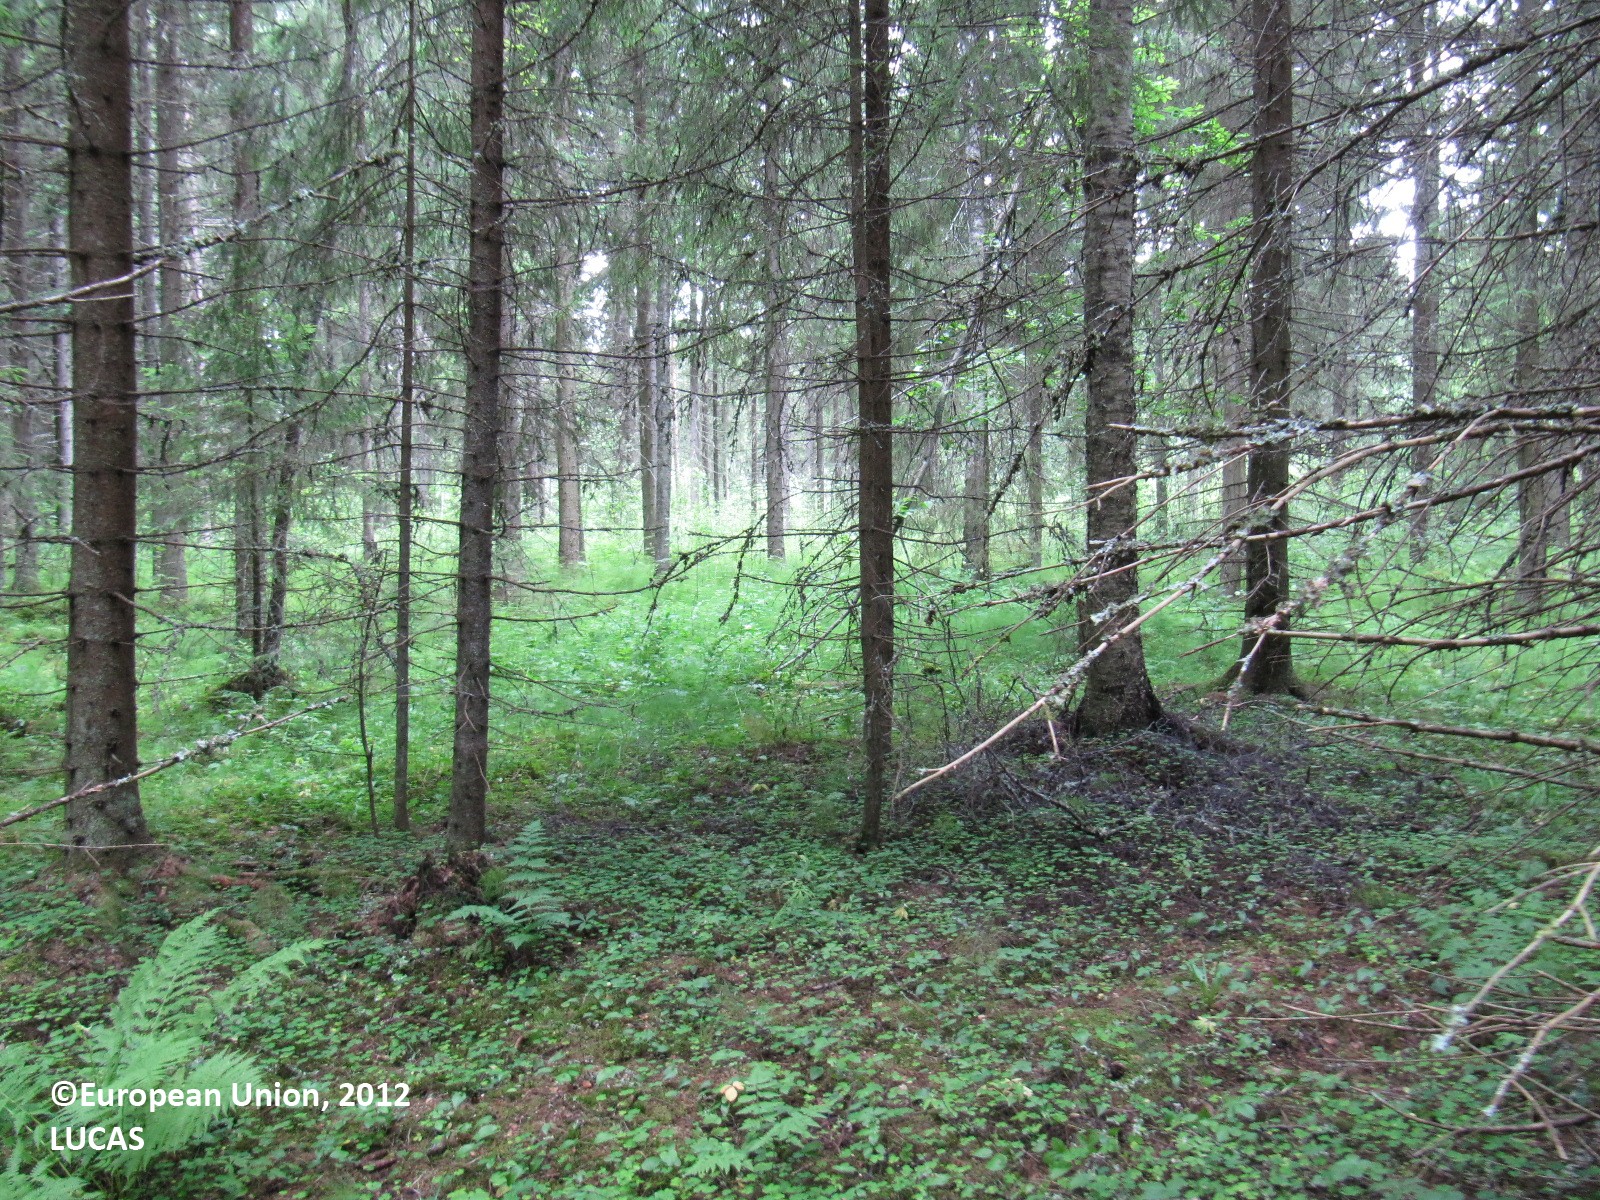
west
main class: Woodland
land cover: Spruce dominated coniferous woodland
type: boreal forest
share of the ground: > 75 %
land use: Forestry
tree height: > 5 m
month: July
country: FI
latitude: 60.9889
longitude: 24.6531
